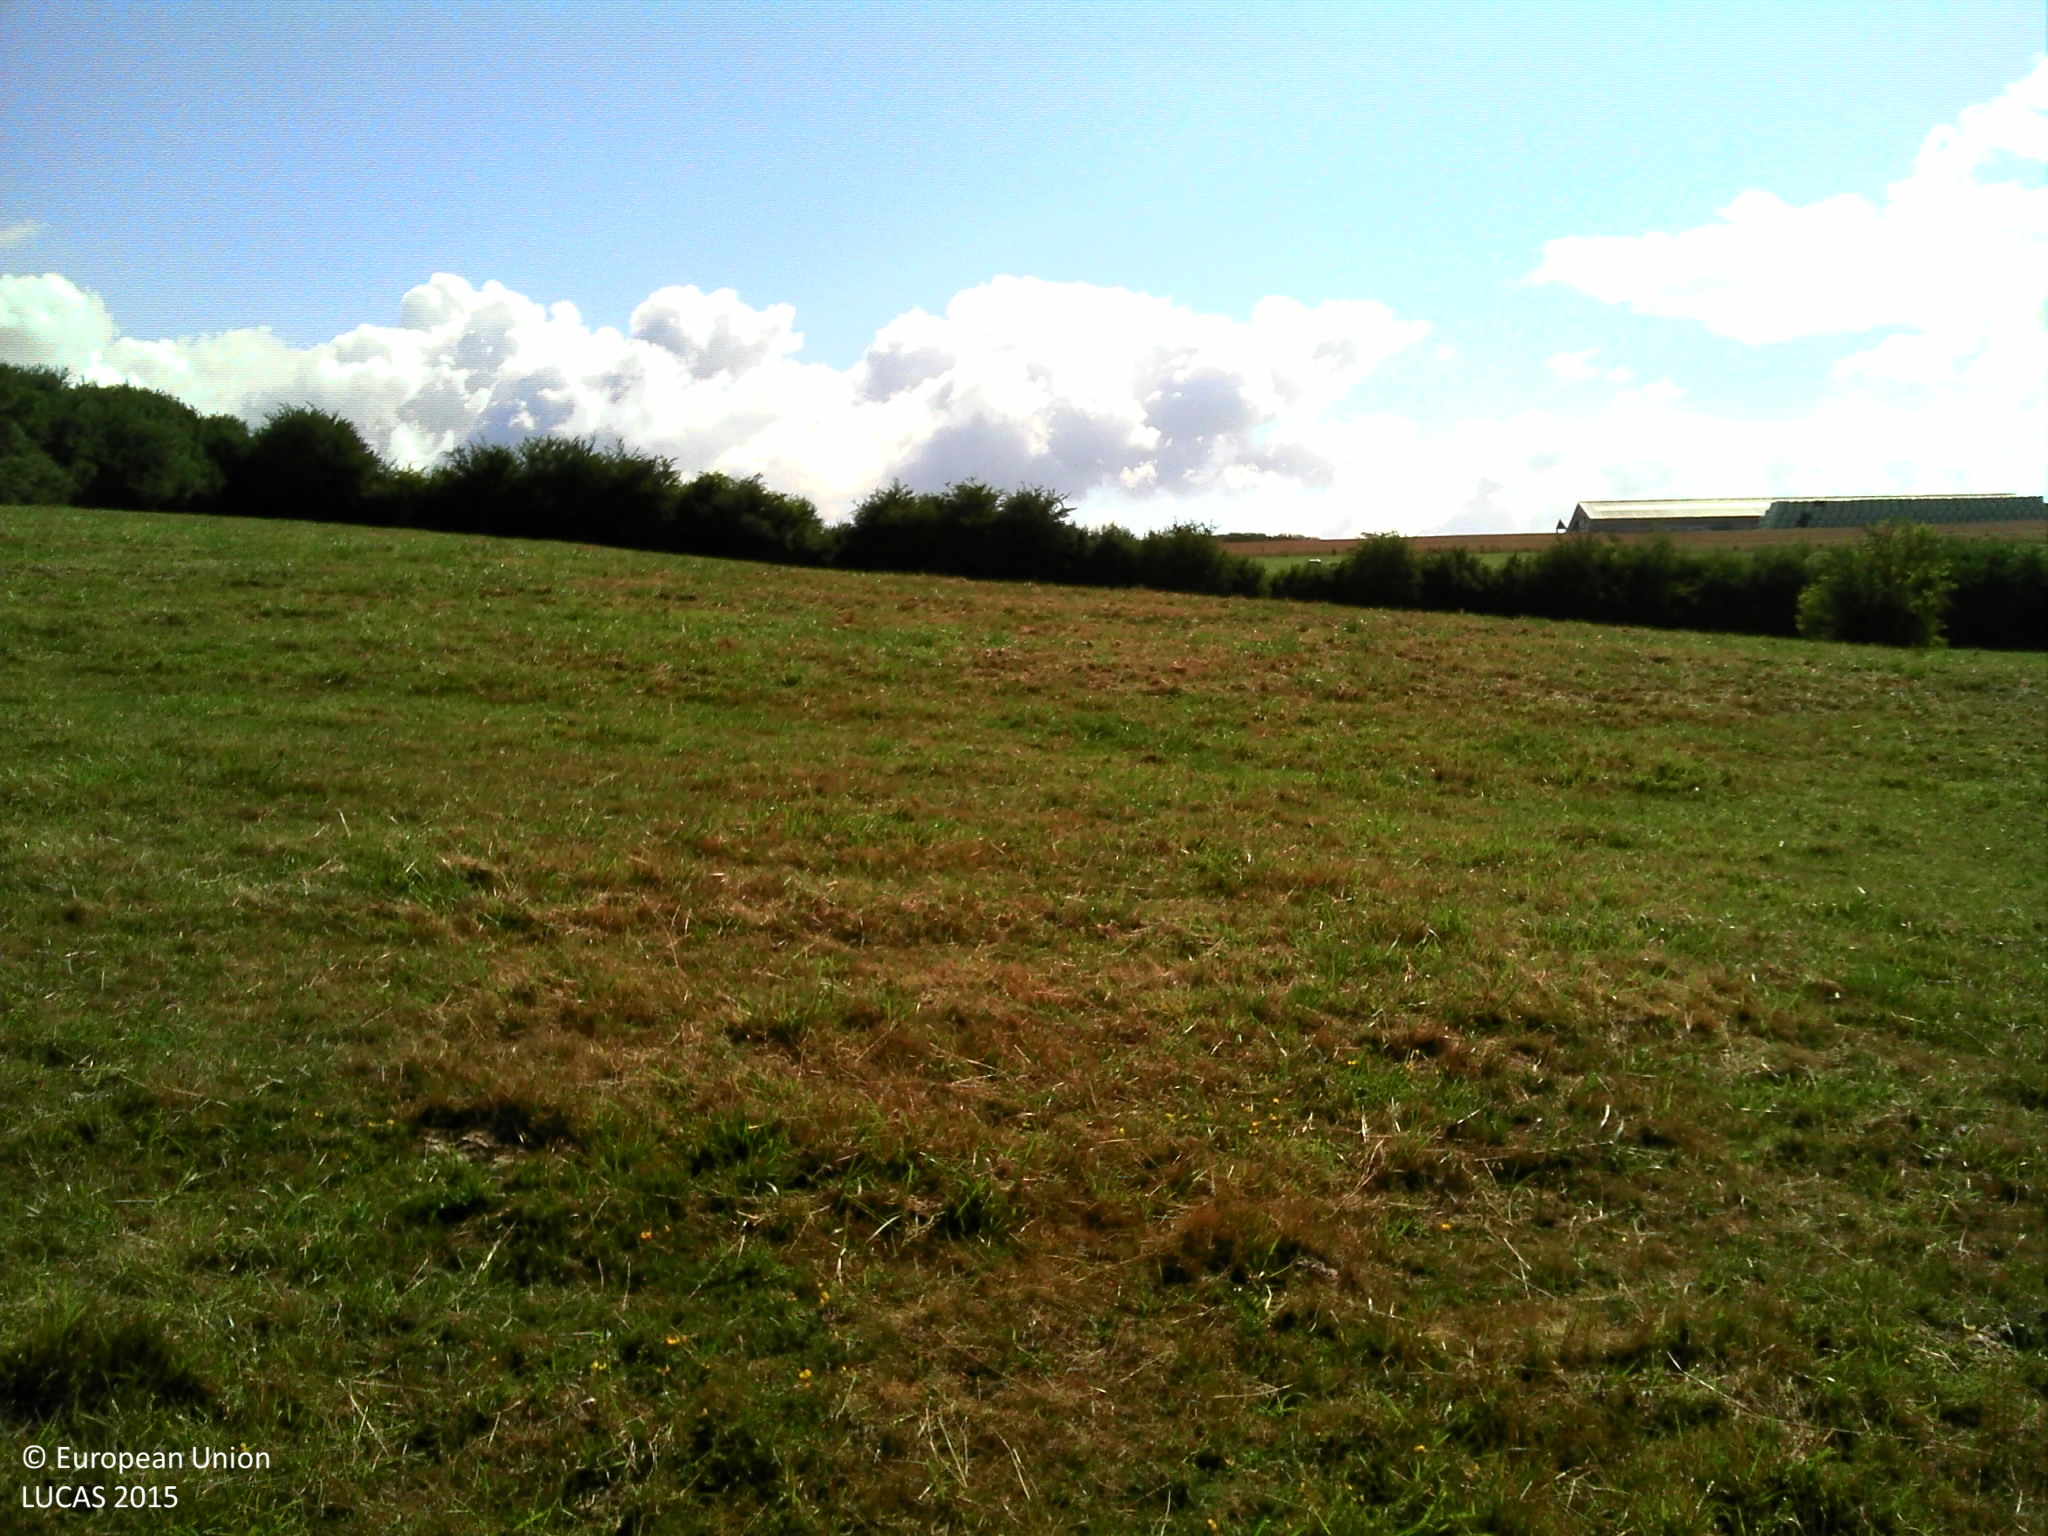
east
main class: Grassland
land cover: Grassland with sparse tree/shrub cover
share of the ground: > 75 %
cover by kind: herbaceous plants 95 %, broadleaved forest trees 5 %
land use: Amenities, museums, leisure
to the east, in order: Grassland with sparse tree/shrub cover; Broadleaved woodland; Fences; Grassland without tree/shrub cover; Fences; Grassland without tree/shrub cover; Fences; Abandoned hedges; Grassland without tree/shrub cover; Fences; Grassland without tree/shrub cover
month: July
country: BE
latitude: 49.5607
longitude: 5.6438
